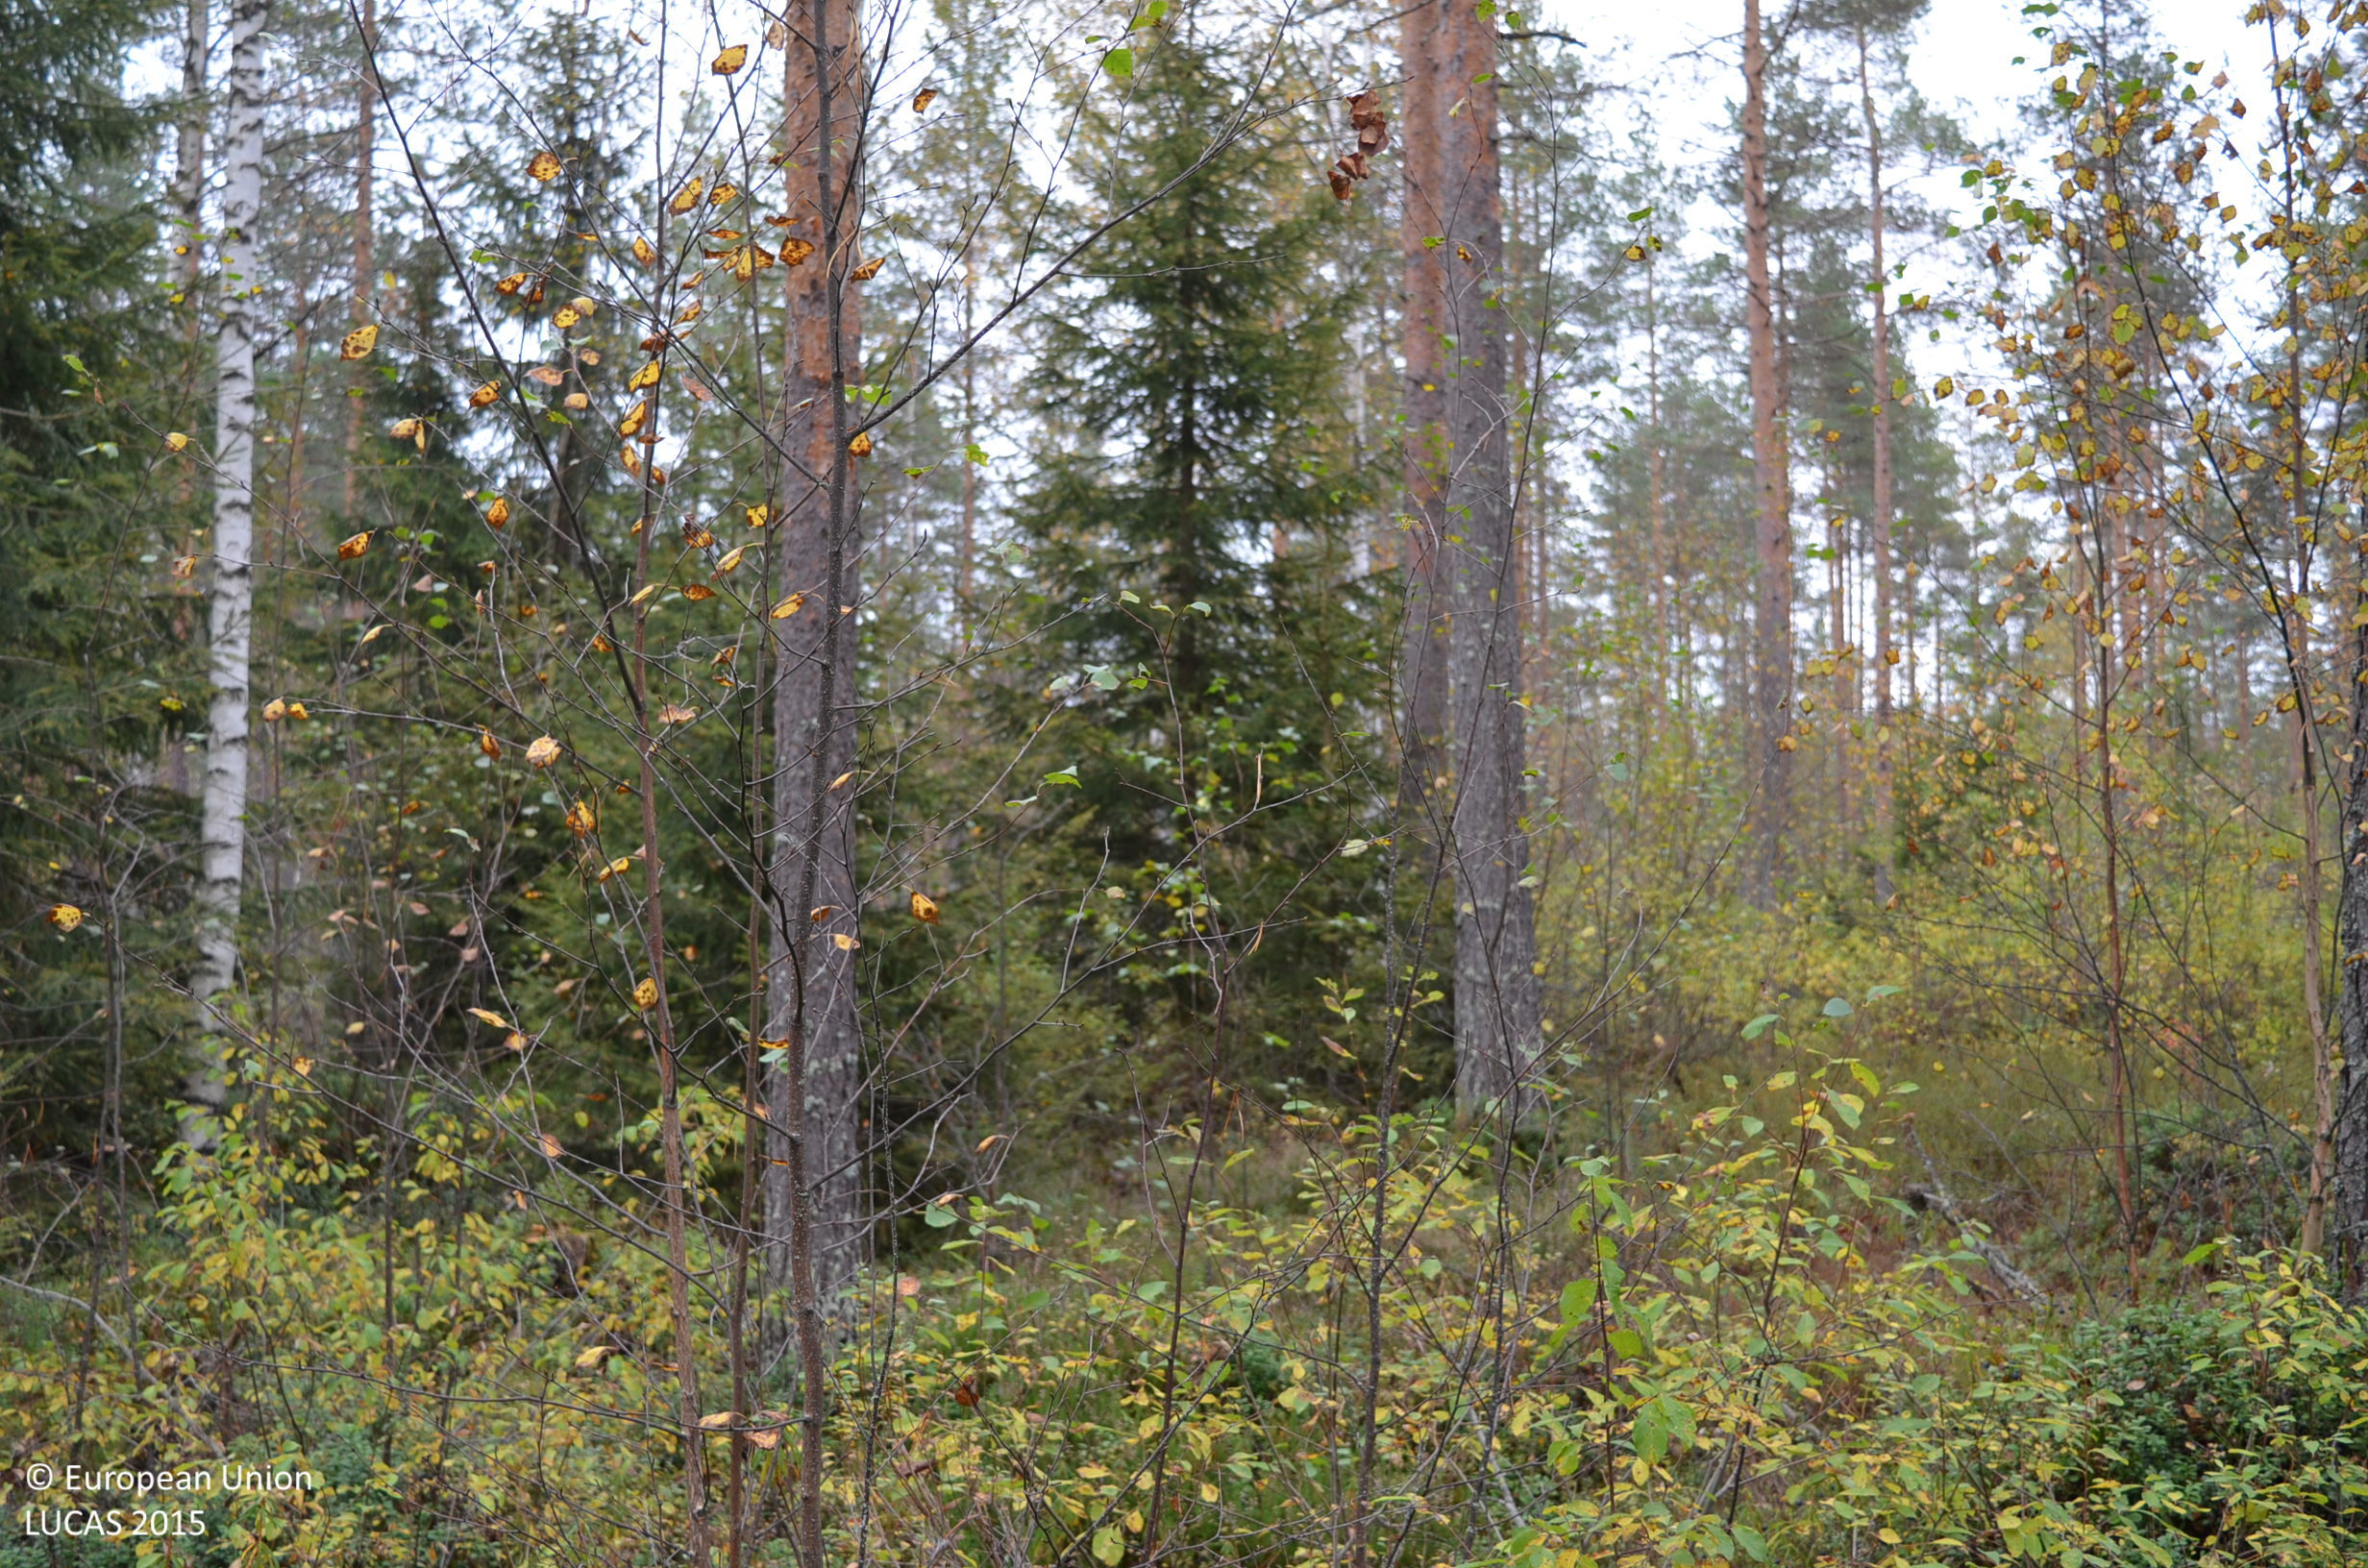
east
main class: Woodland
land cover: Pine dominated mixed woodland
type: boreal forest
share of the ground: 50 - 75 %
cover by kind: coniferous forest trees 40 %, shrubs 35 %, broadleaved forest trees 25 %
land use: Forestry
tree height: > 5 m
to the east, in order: Pine dominated mixed woodland; Other mixed woodland; Ditches and canals; Pine dominated mixed woodland; Ditches and canals; Pine dominated coniferous woodland; Ditches and canals; Pine dominated mixed woodland; Ditches and canals; Pine dominated mixed woodland; Ditches and canals; Pine dominated mixed woodland
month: September
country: FI
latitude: 62.7621
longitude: 23.8028
